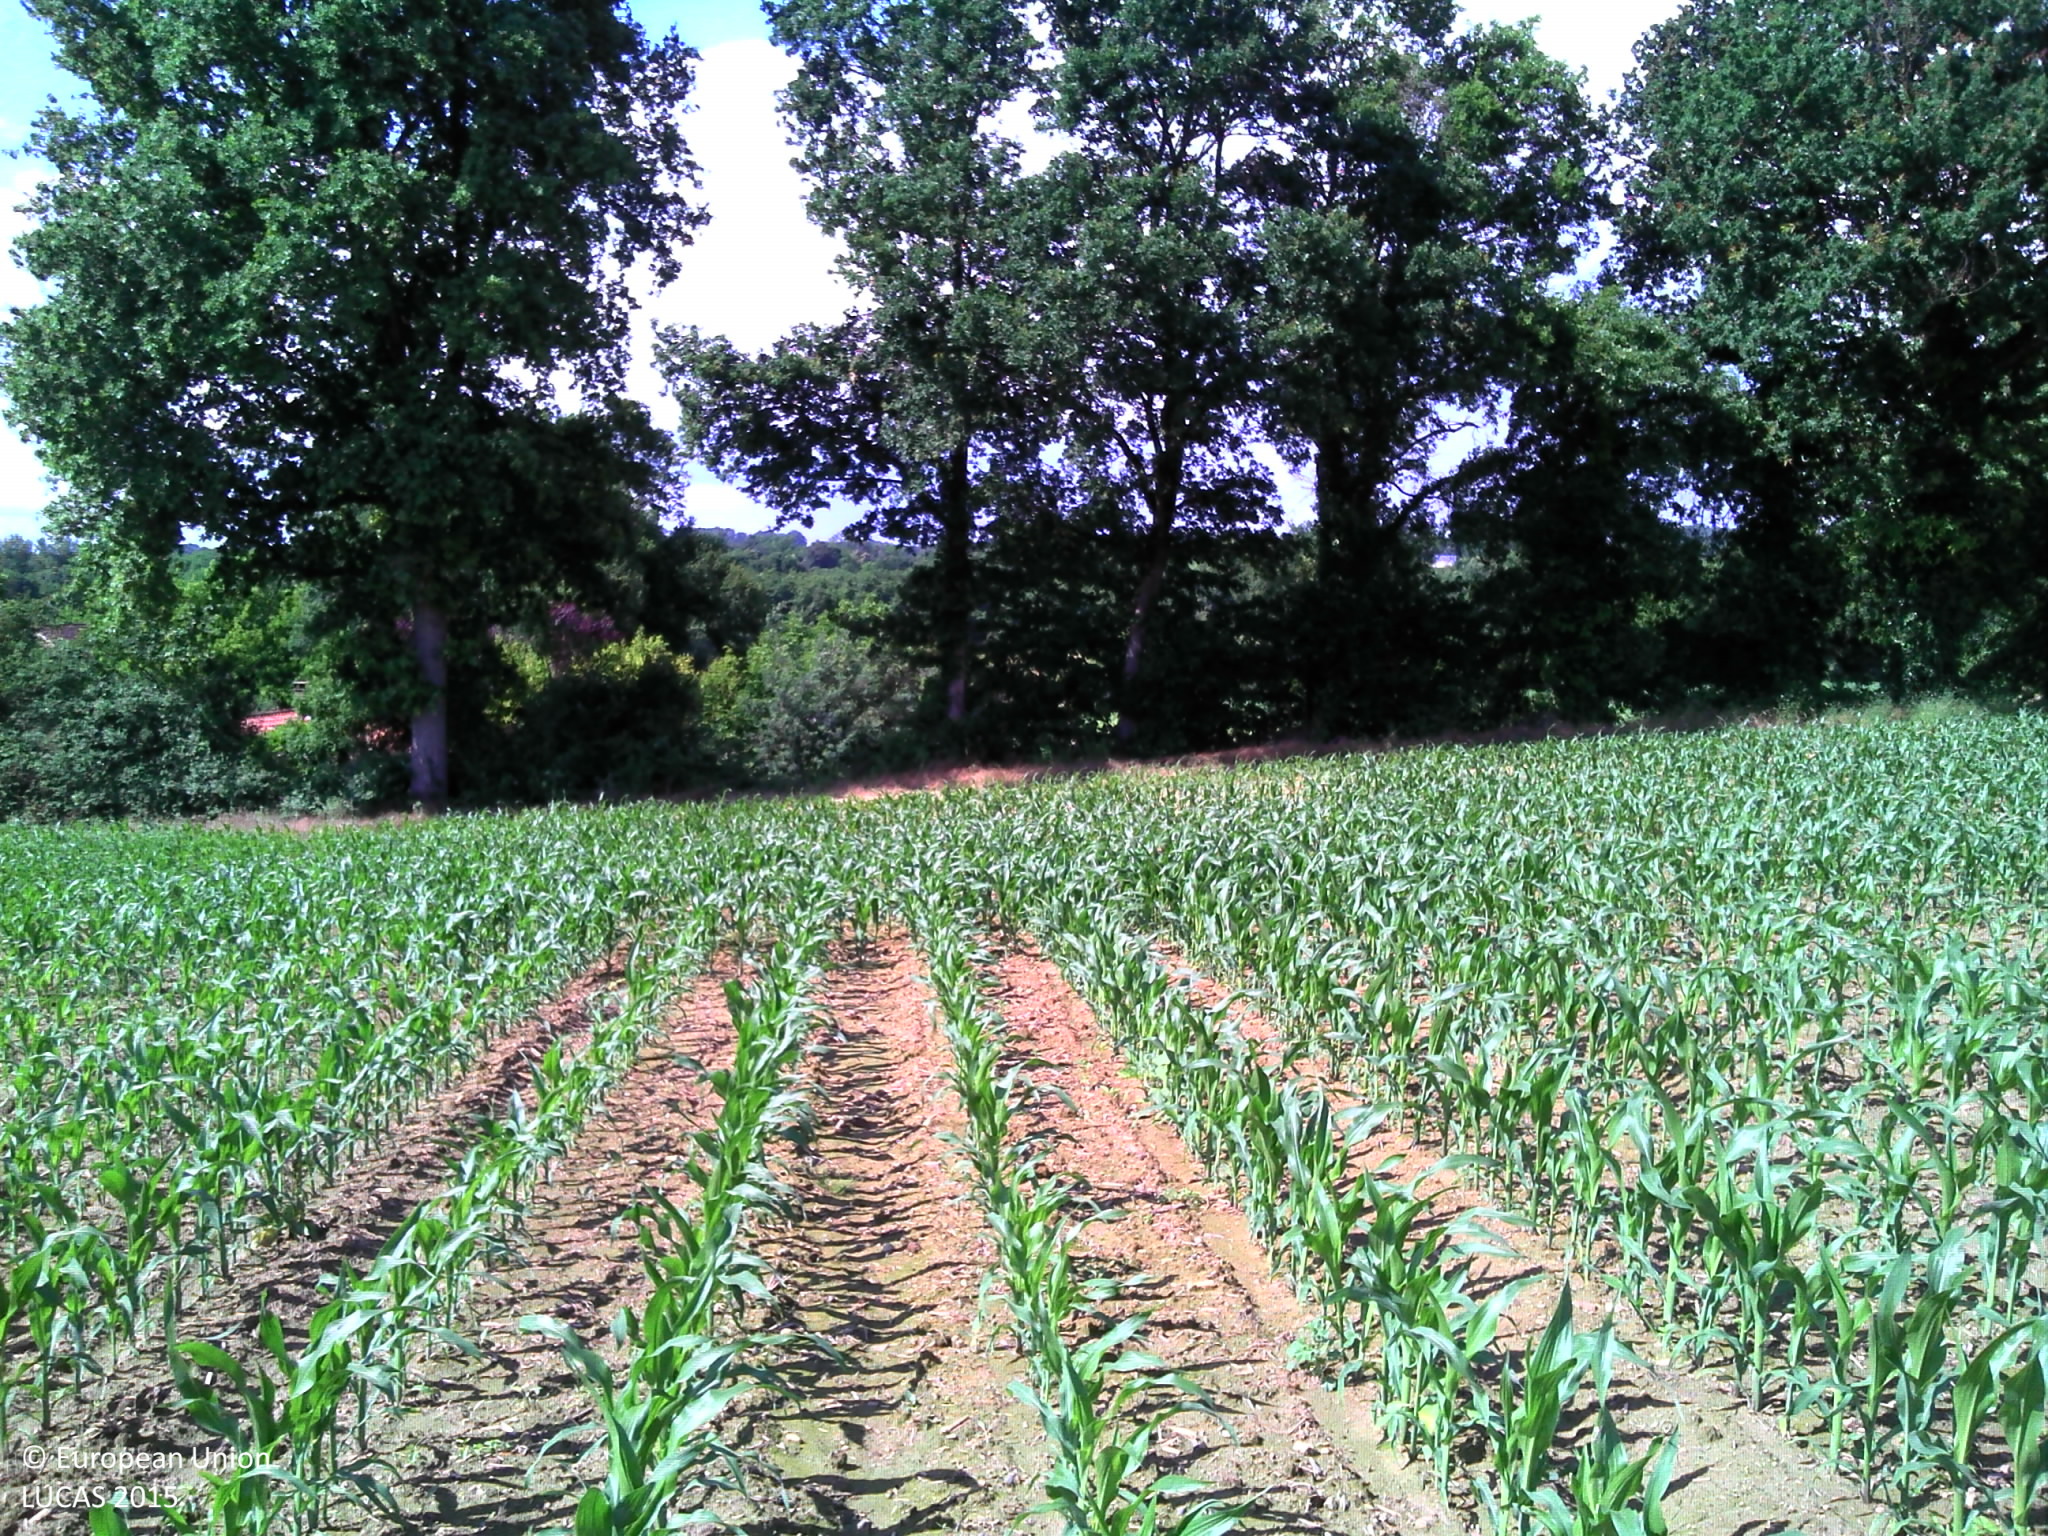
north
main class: Cropland
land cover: Maize
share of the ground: 25 - 50 %
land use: Agriculture (excluding fallow land and kitchen gardens)
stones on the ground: < 10 %
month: June
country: FR
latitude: 43.8064
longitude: -0.2395
